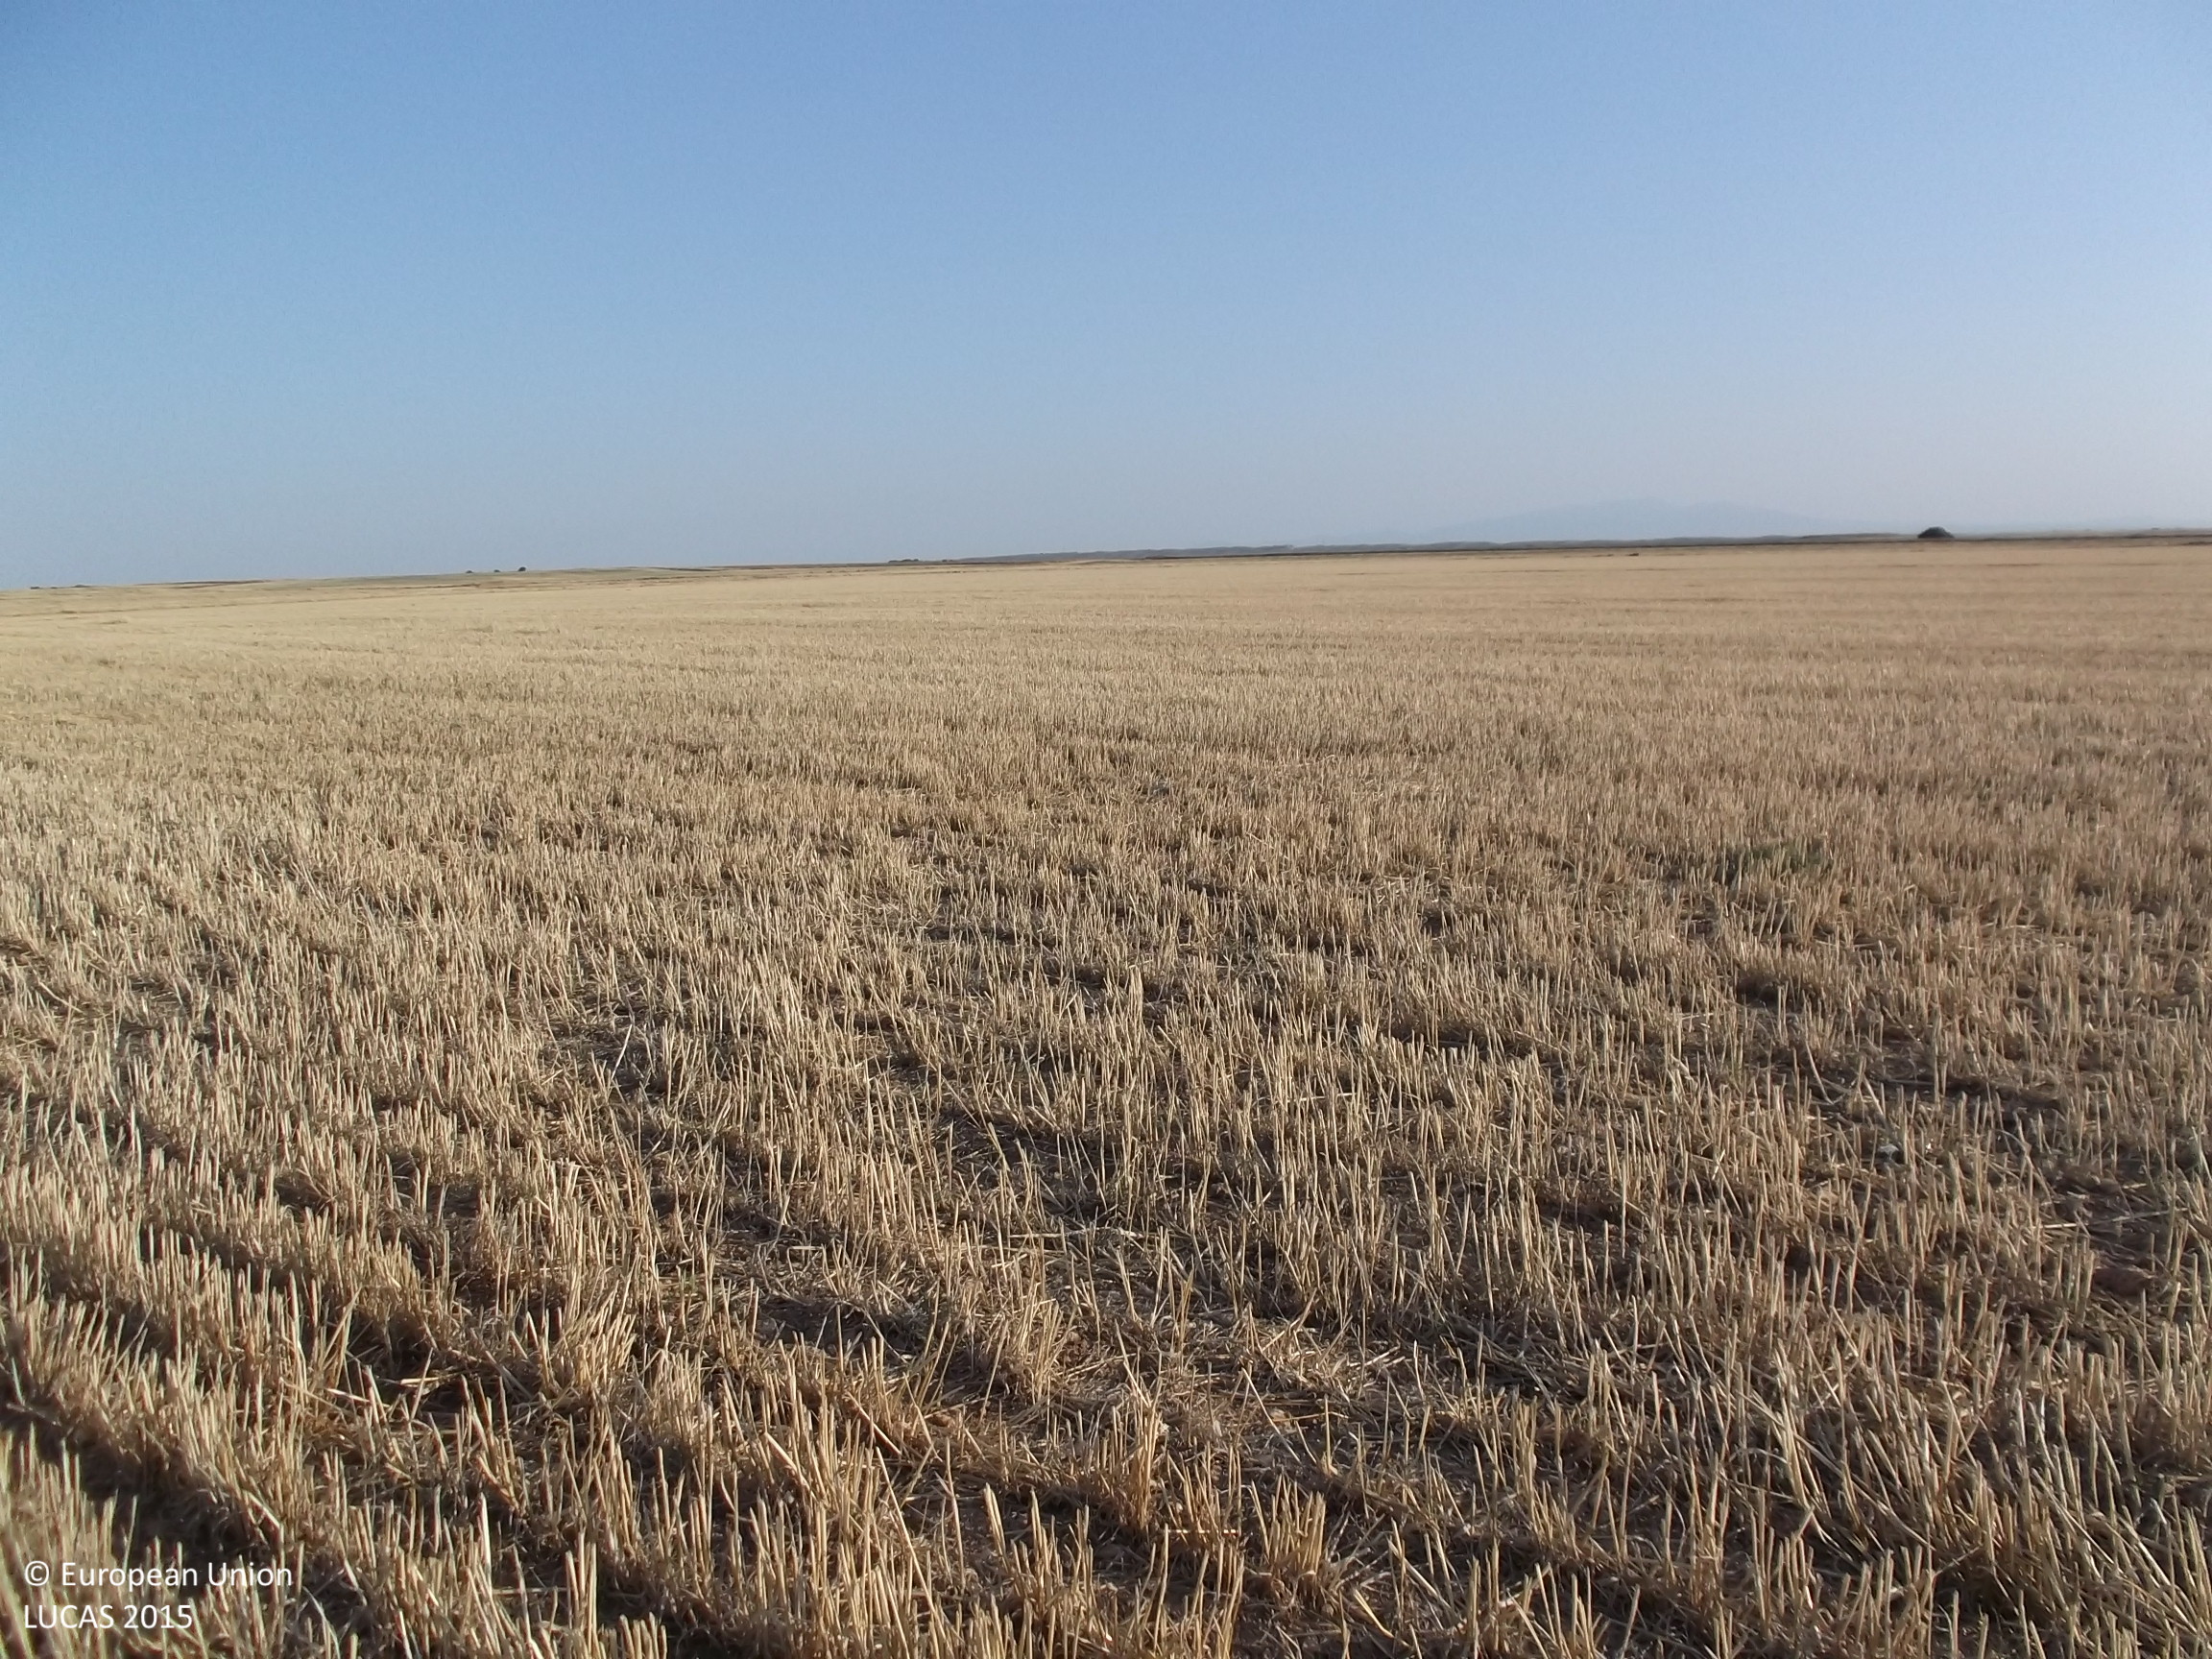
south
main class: Cropland
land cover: Barley
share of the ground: < 10 %
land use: Agriculture (excluding fallow land and kitchen gardens)
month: July
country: ES
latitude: 42.2808
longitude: -1.5656
